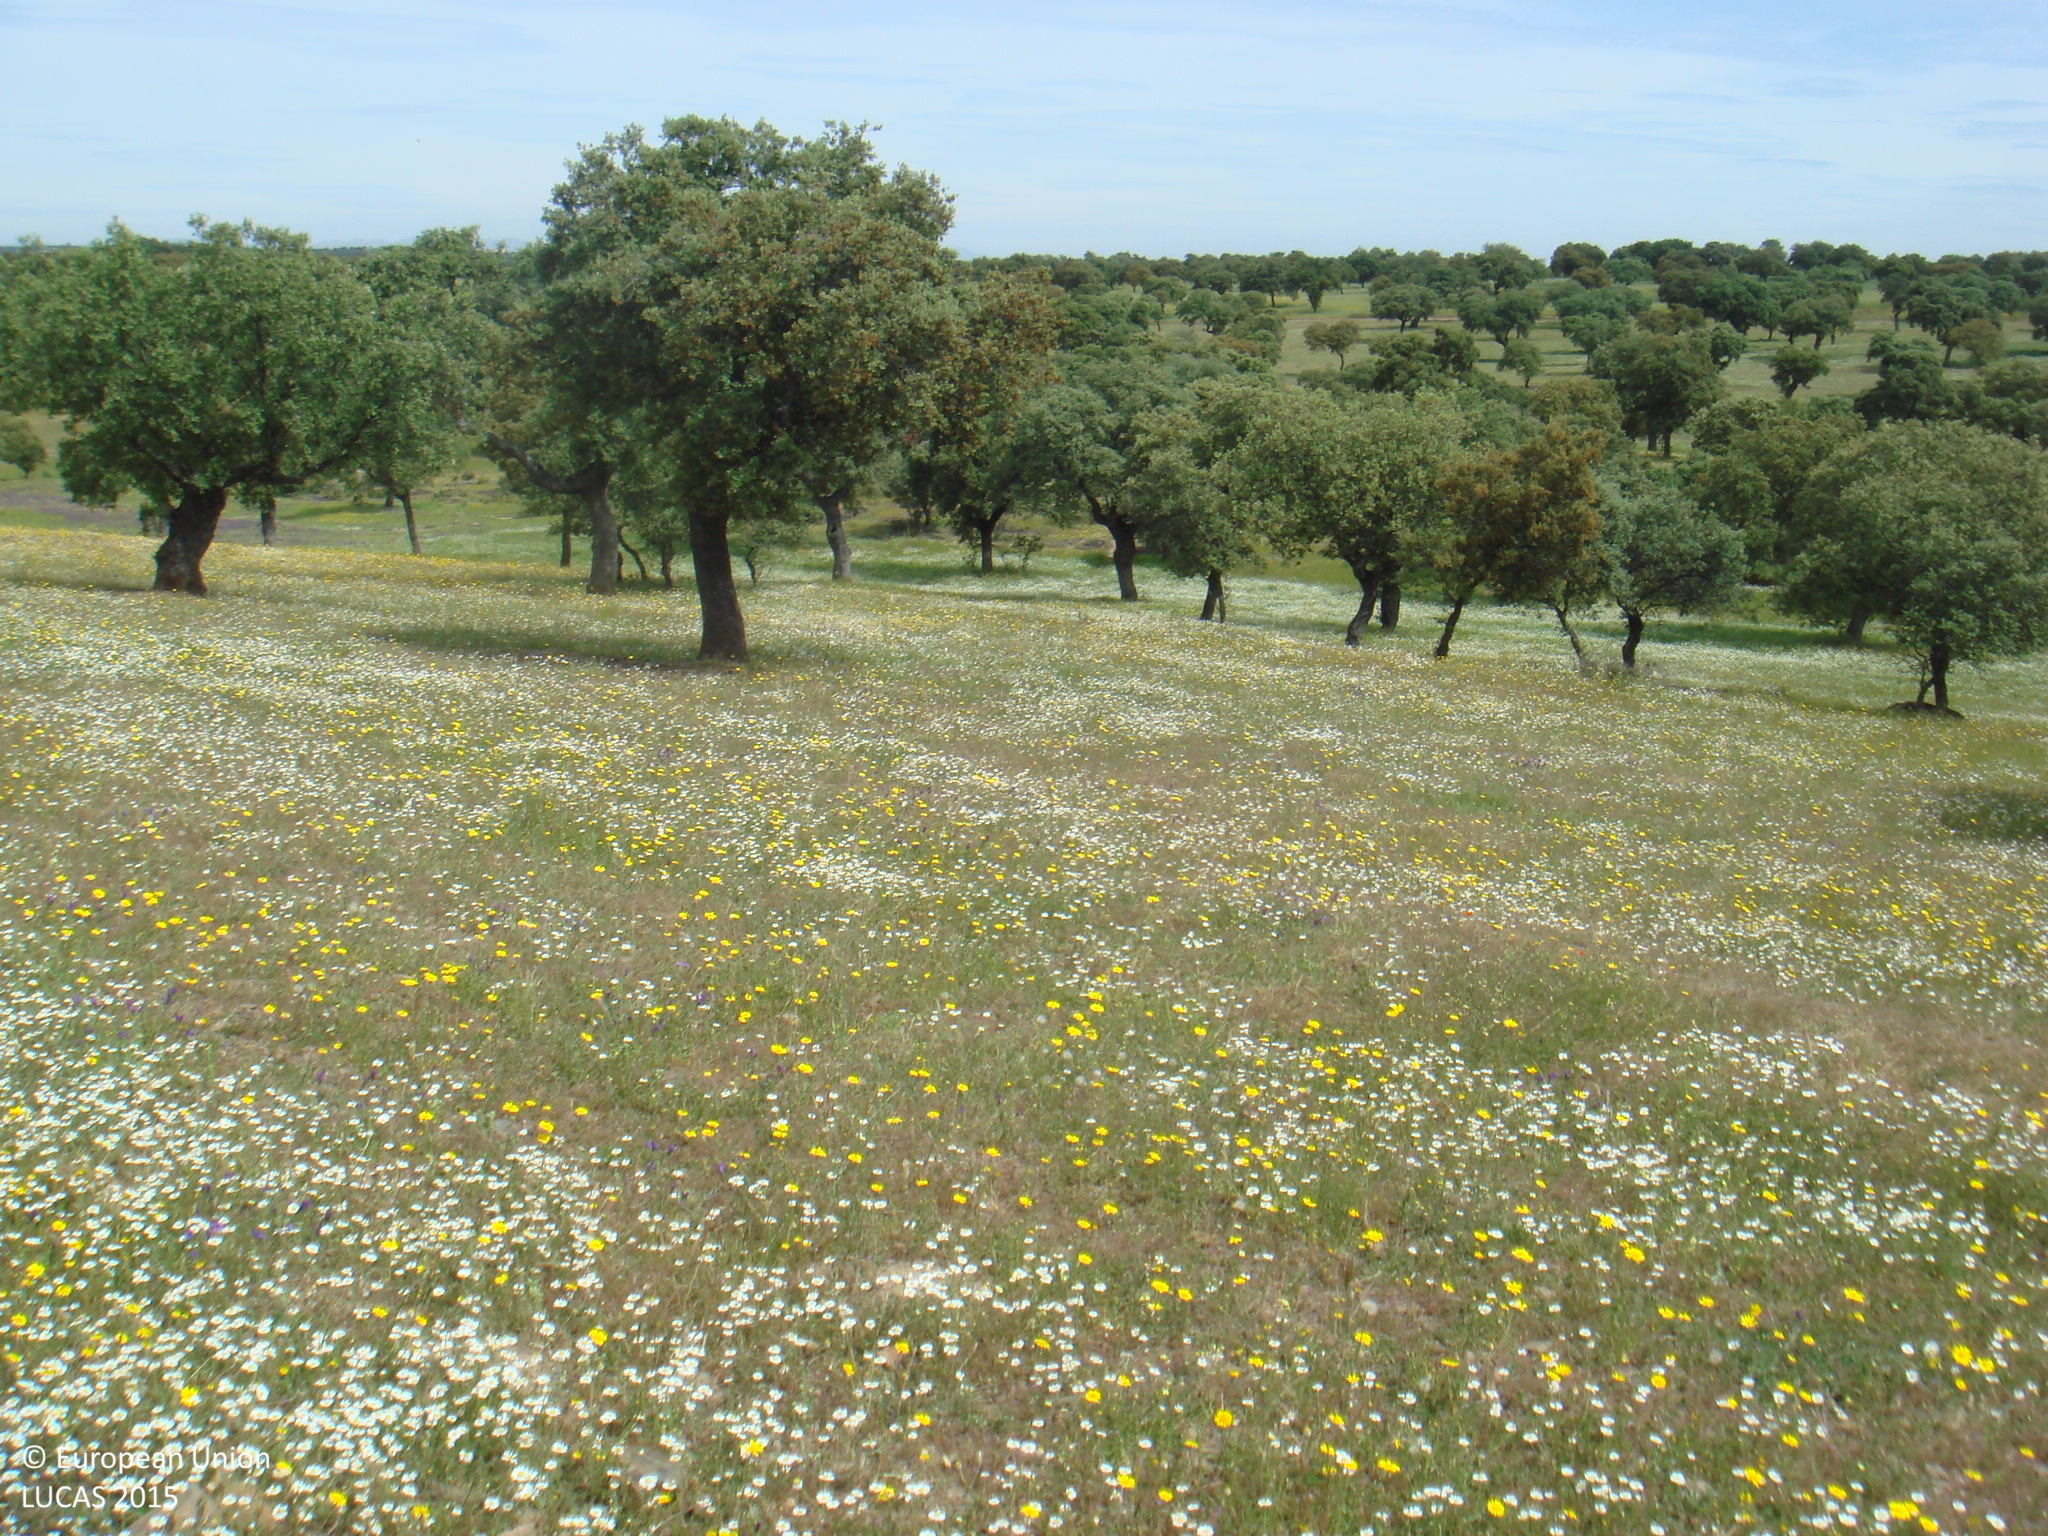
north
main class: Woodland
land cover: Broadleaved woodland
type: broadleaved evergreen forest
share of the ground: 25 - 50 %
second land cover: Grassland without tree/shrub cover
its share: > 75 %
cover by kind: herbaceous plants 70 %, broadleaved forest trees 30 %
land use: Forestry
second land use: Agriculture (excluding fallow land and kitchen gardens)
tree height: > 5 m
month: May
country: ES
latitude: 38.3775
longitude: -5.0796
